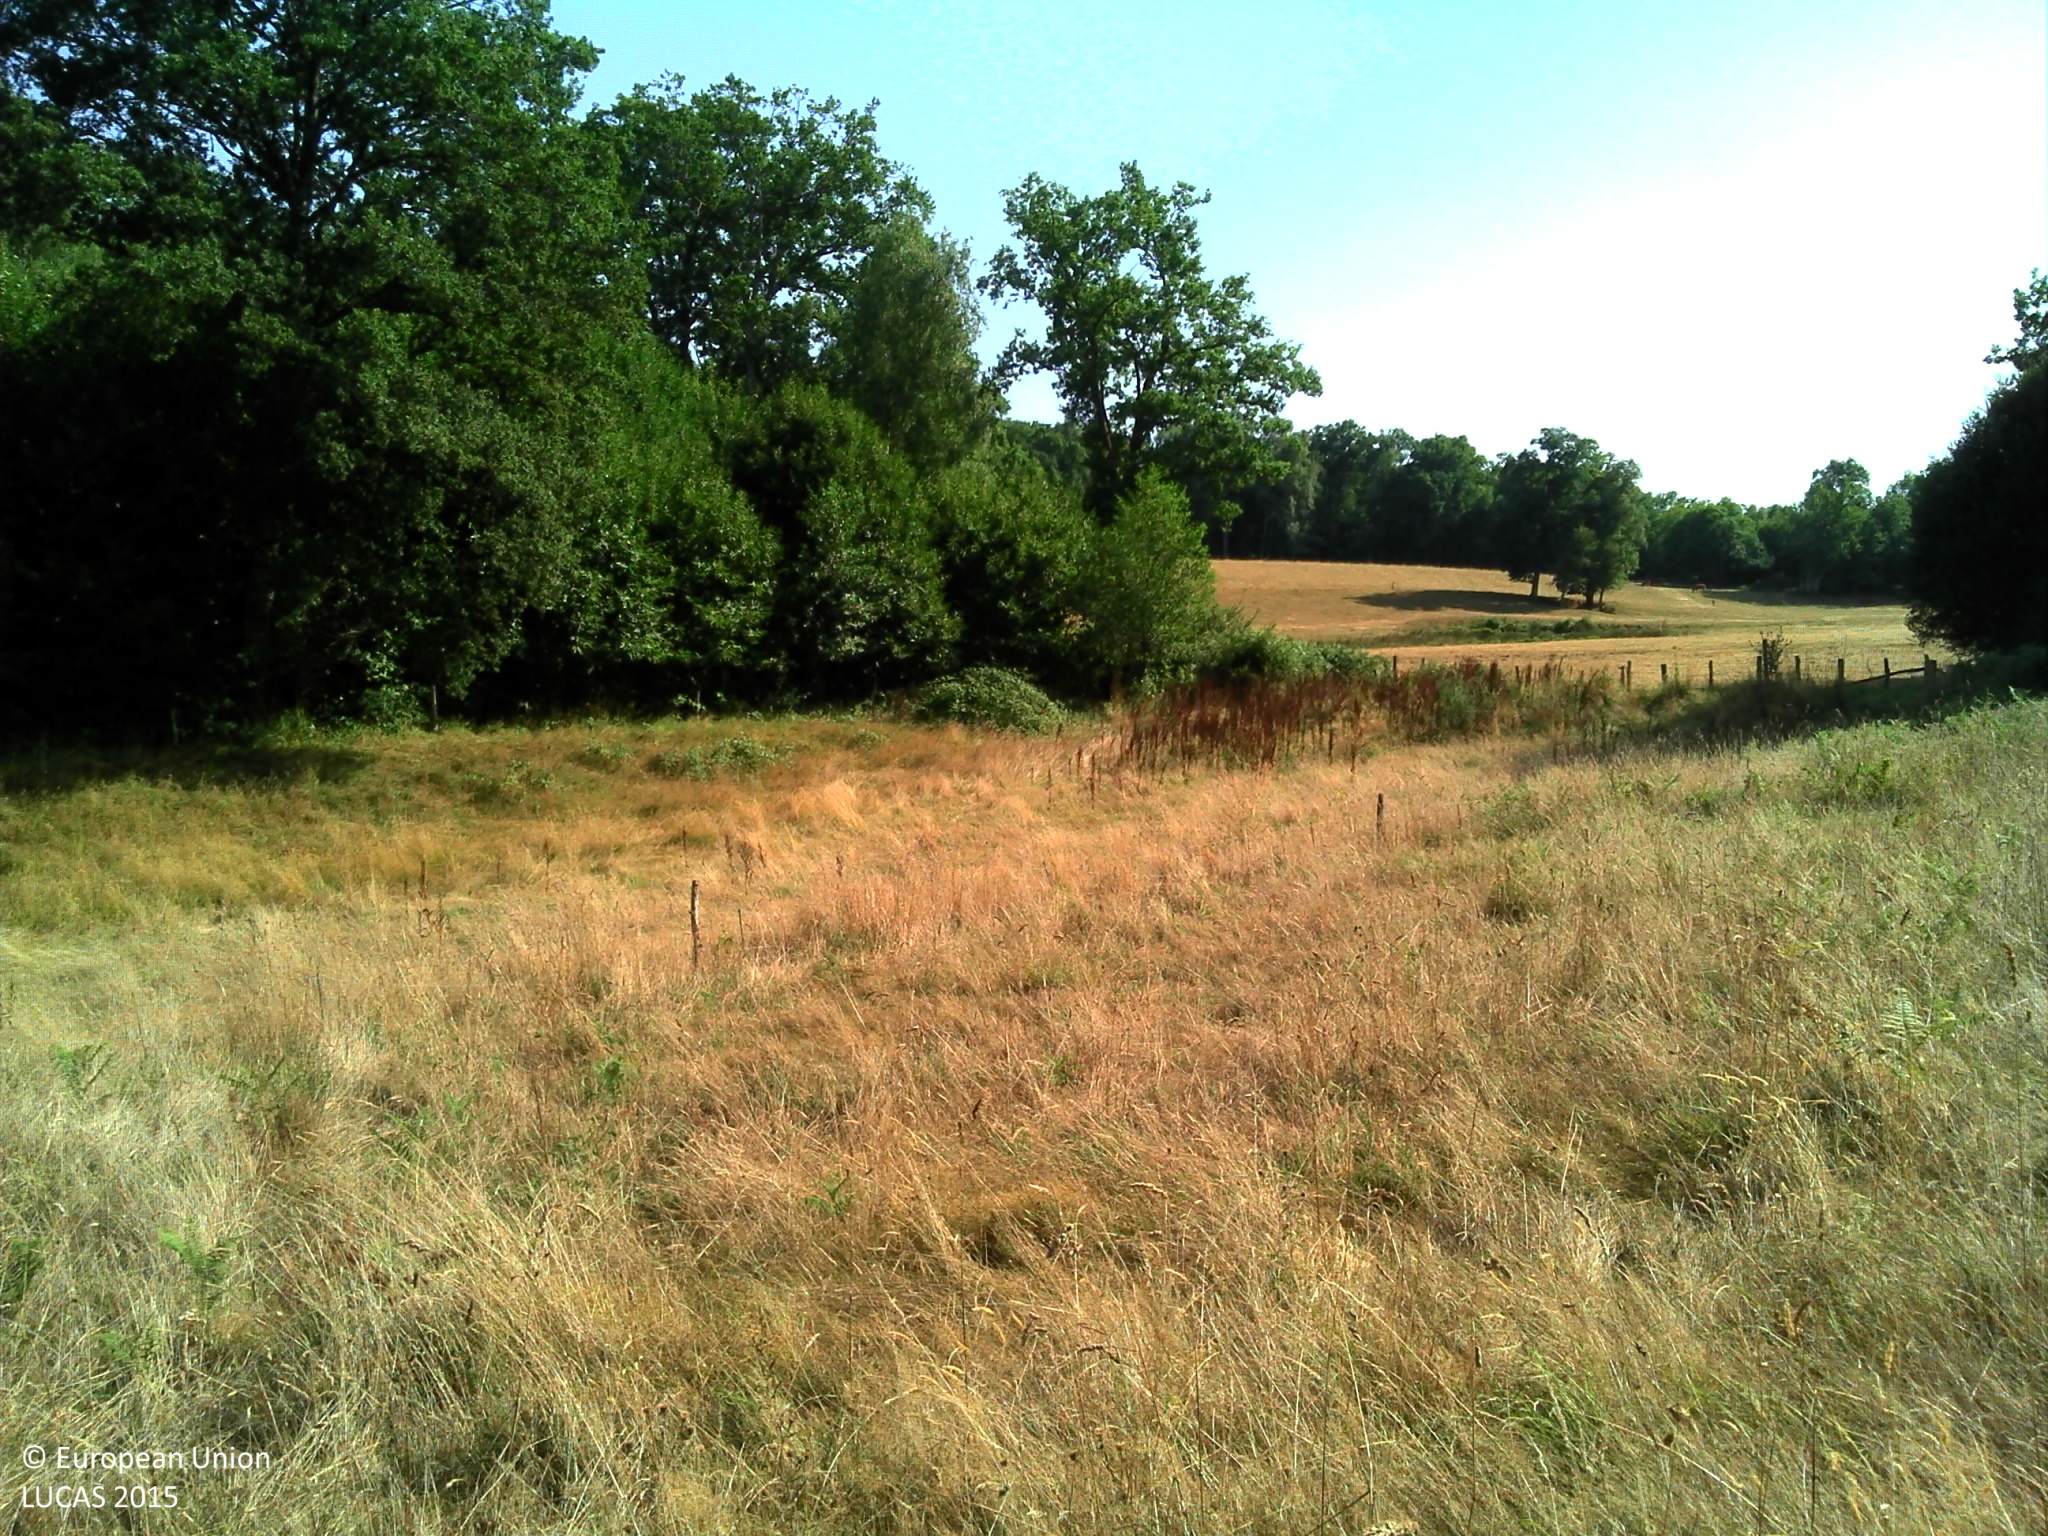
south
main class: Grassland
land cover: Grassland without tree/shrub cover
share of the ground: > 75 %
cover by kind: herbaceous plants 95 %, lichens and mosses 5 %
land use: Agriculture (excluding fallow land and kitchen gardens)
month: August
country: FR
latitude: 45.4123
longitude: 1.0339
